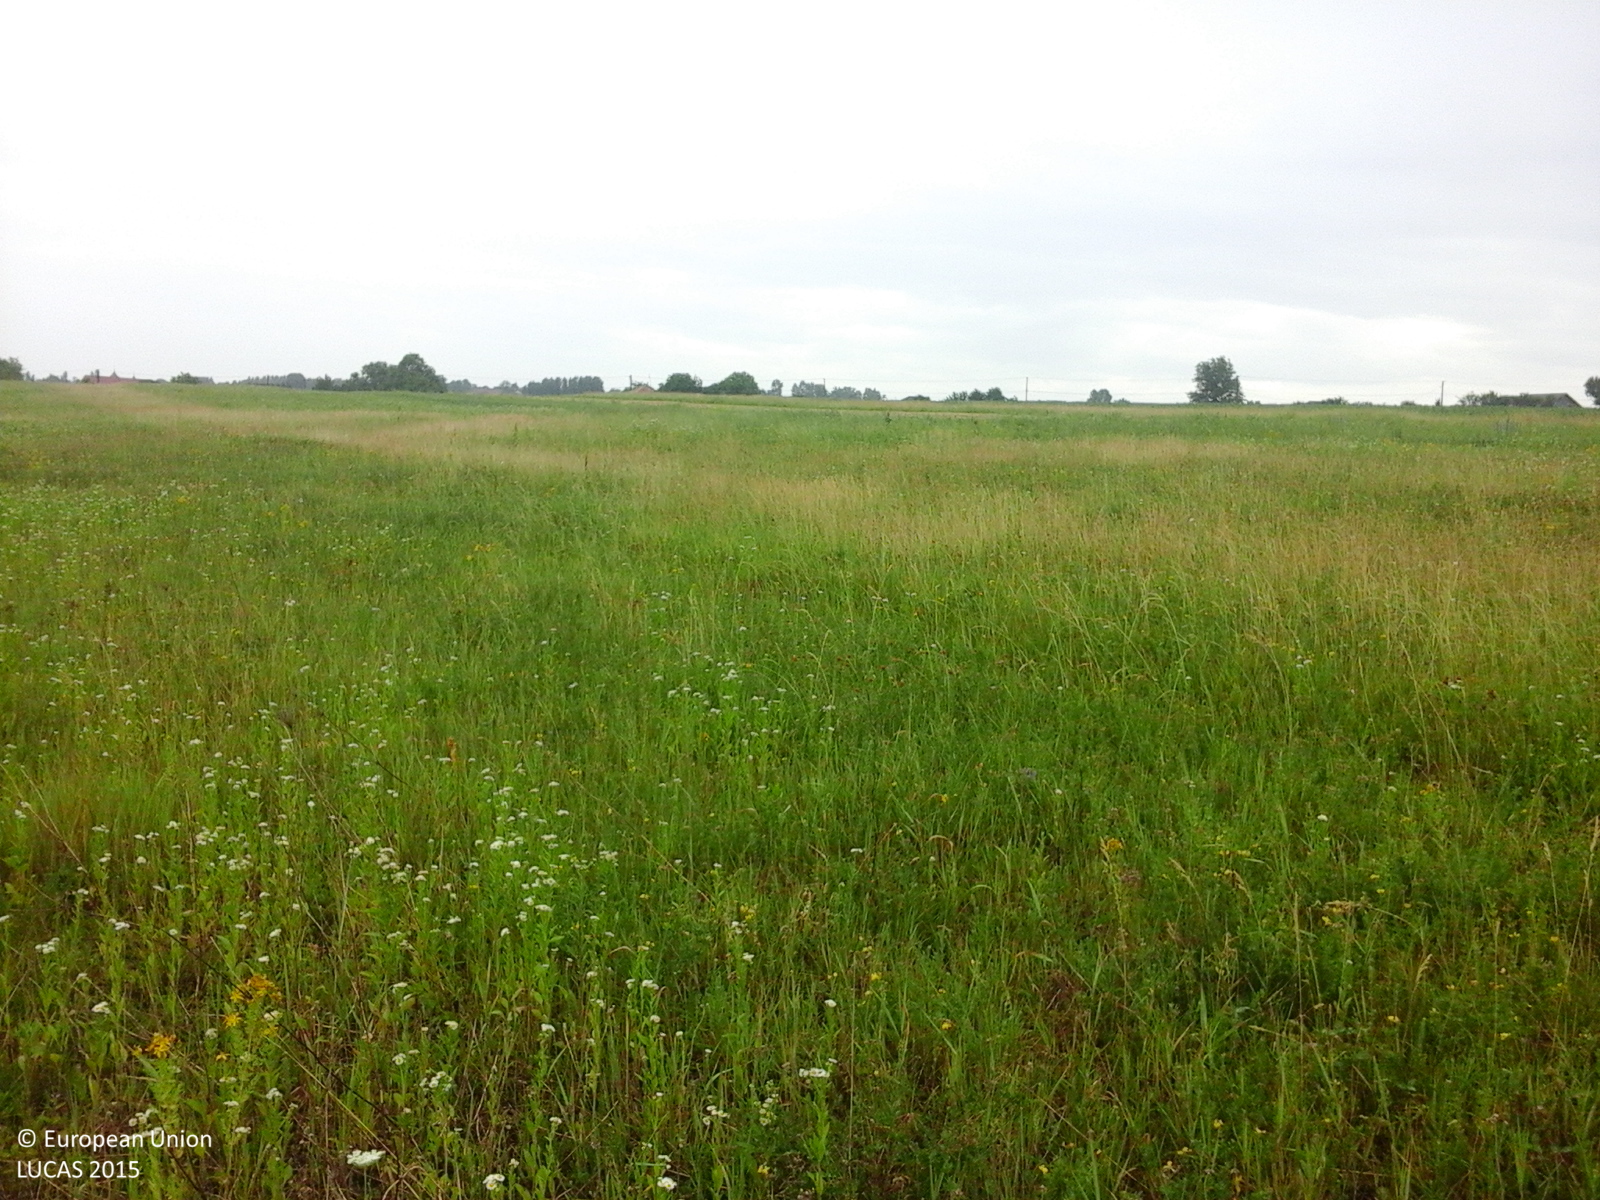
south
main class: Grassland
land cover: Grassland without tree/shrub cover
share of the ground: > 75 %
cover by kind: herbaceous plants 100 %
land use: Agriculture (excluding fallow land and kitchen gardens)
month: June
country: RO
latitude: 47.3598
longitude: 26.4650
